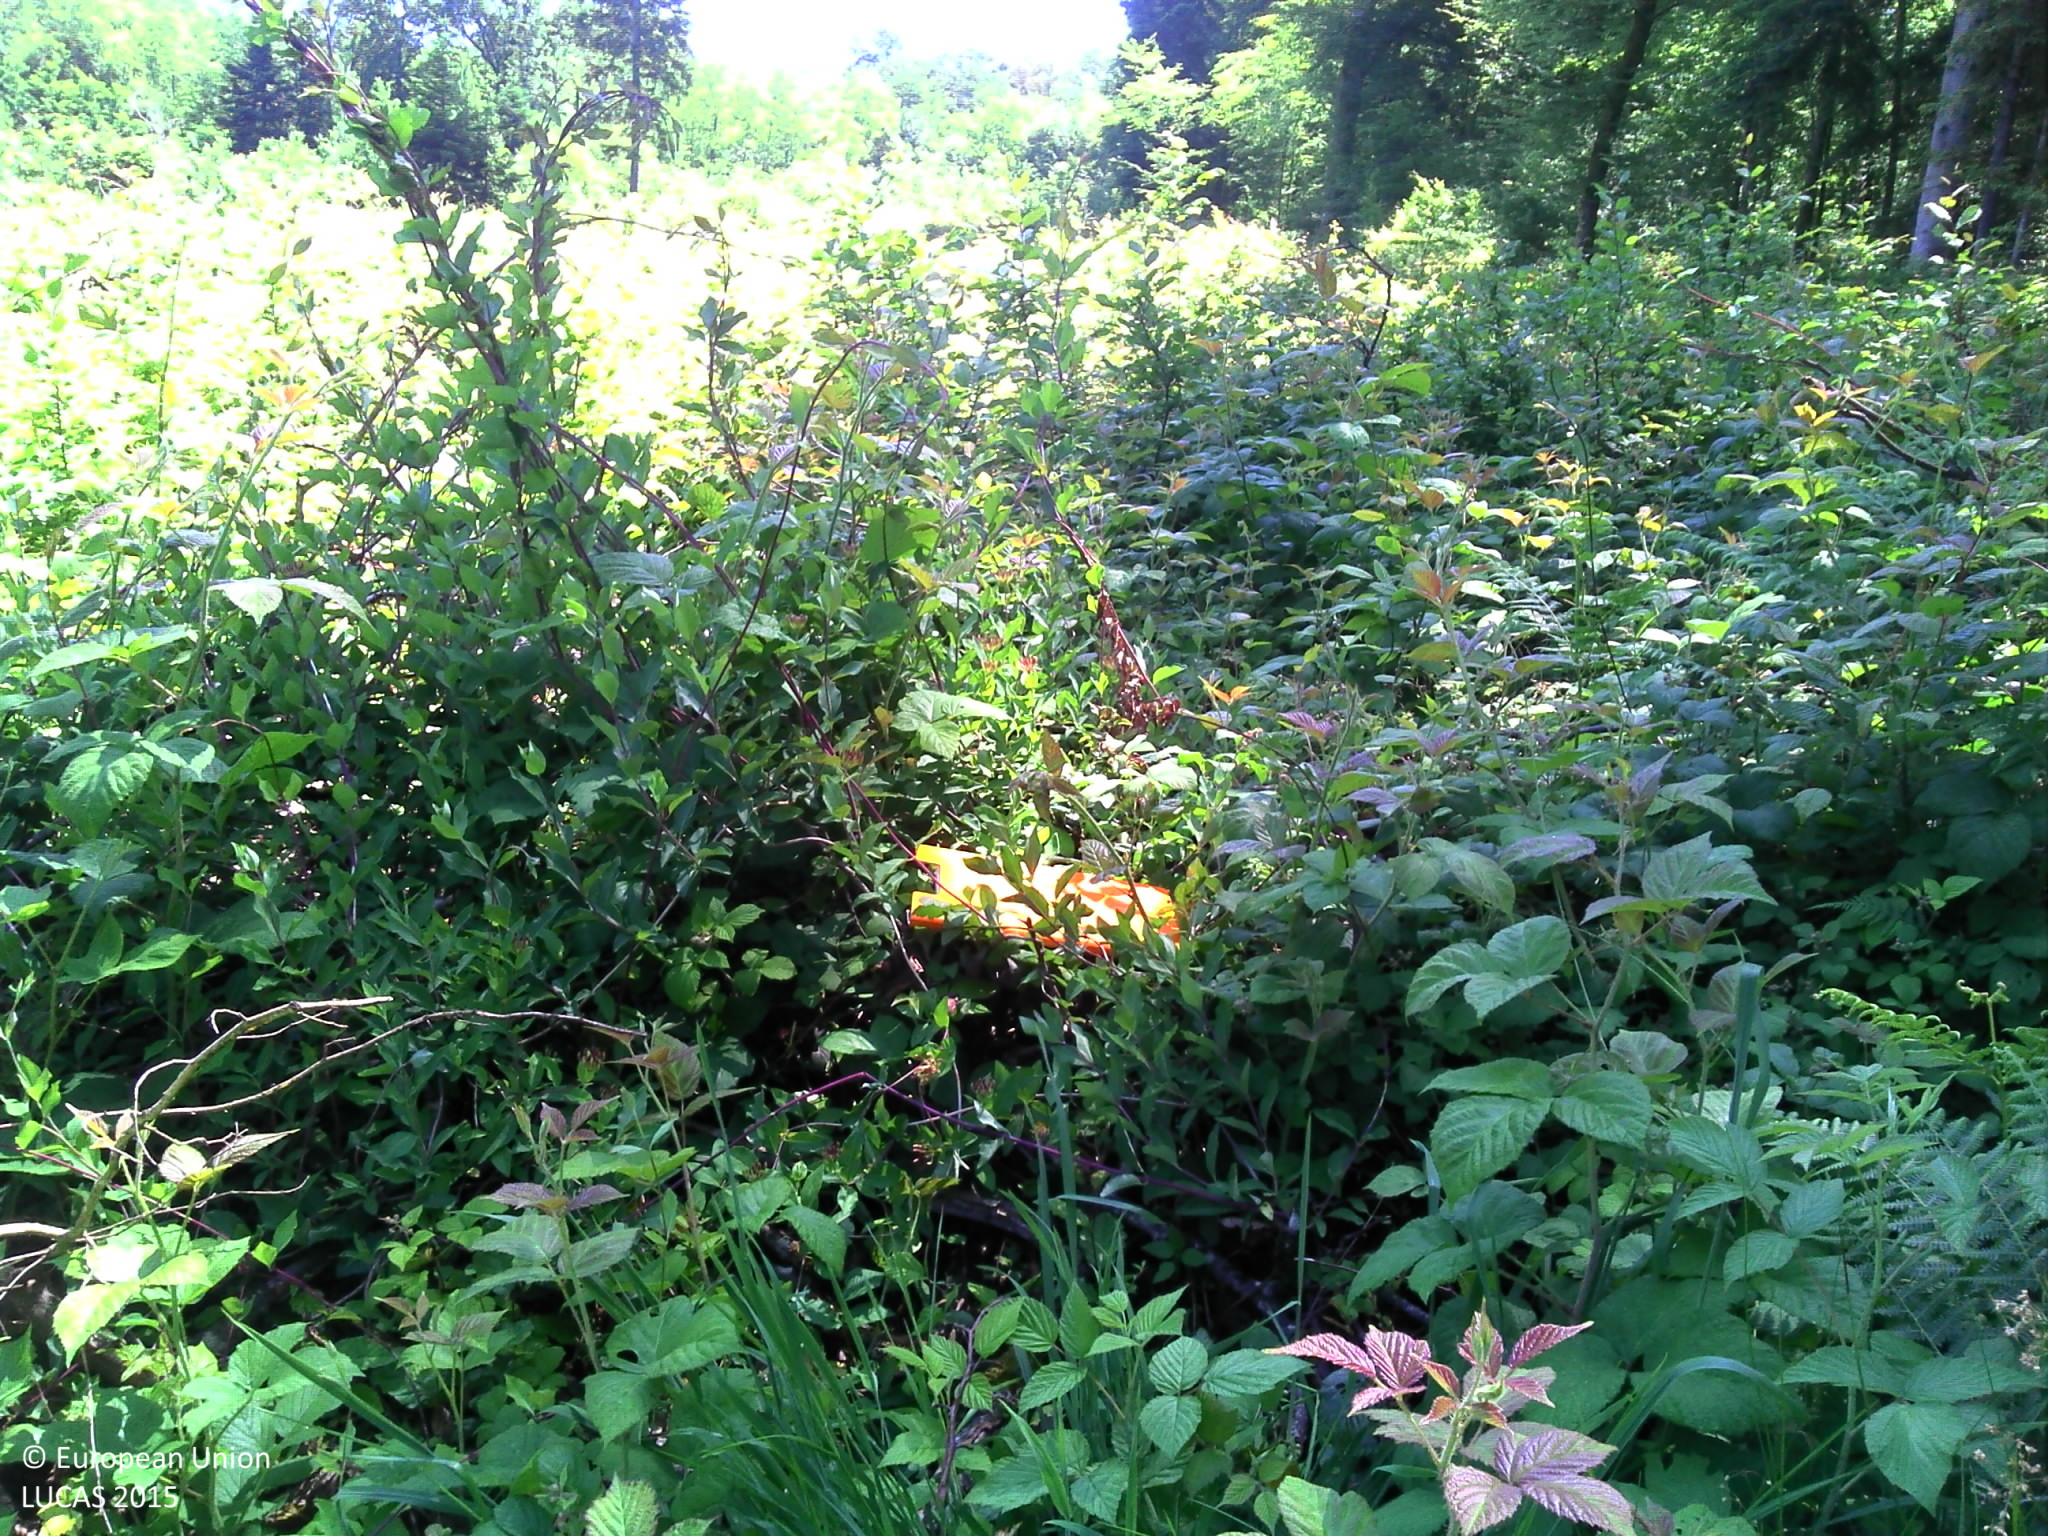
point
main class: Woodland
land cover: Broadleaved woodland
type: mesophytic deciduous forest
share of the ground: > 75 %
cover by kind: broadleaved forest trees 55 %, shrubs 20 %, herbaceous plants 15 %, coniferous forest trees 5 %, unconsolidated bare surface 5 %
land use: Forestry
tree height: < 5 m
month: June
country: FR
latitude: 47.5933
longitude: 6.0249
